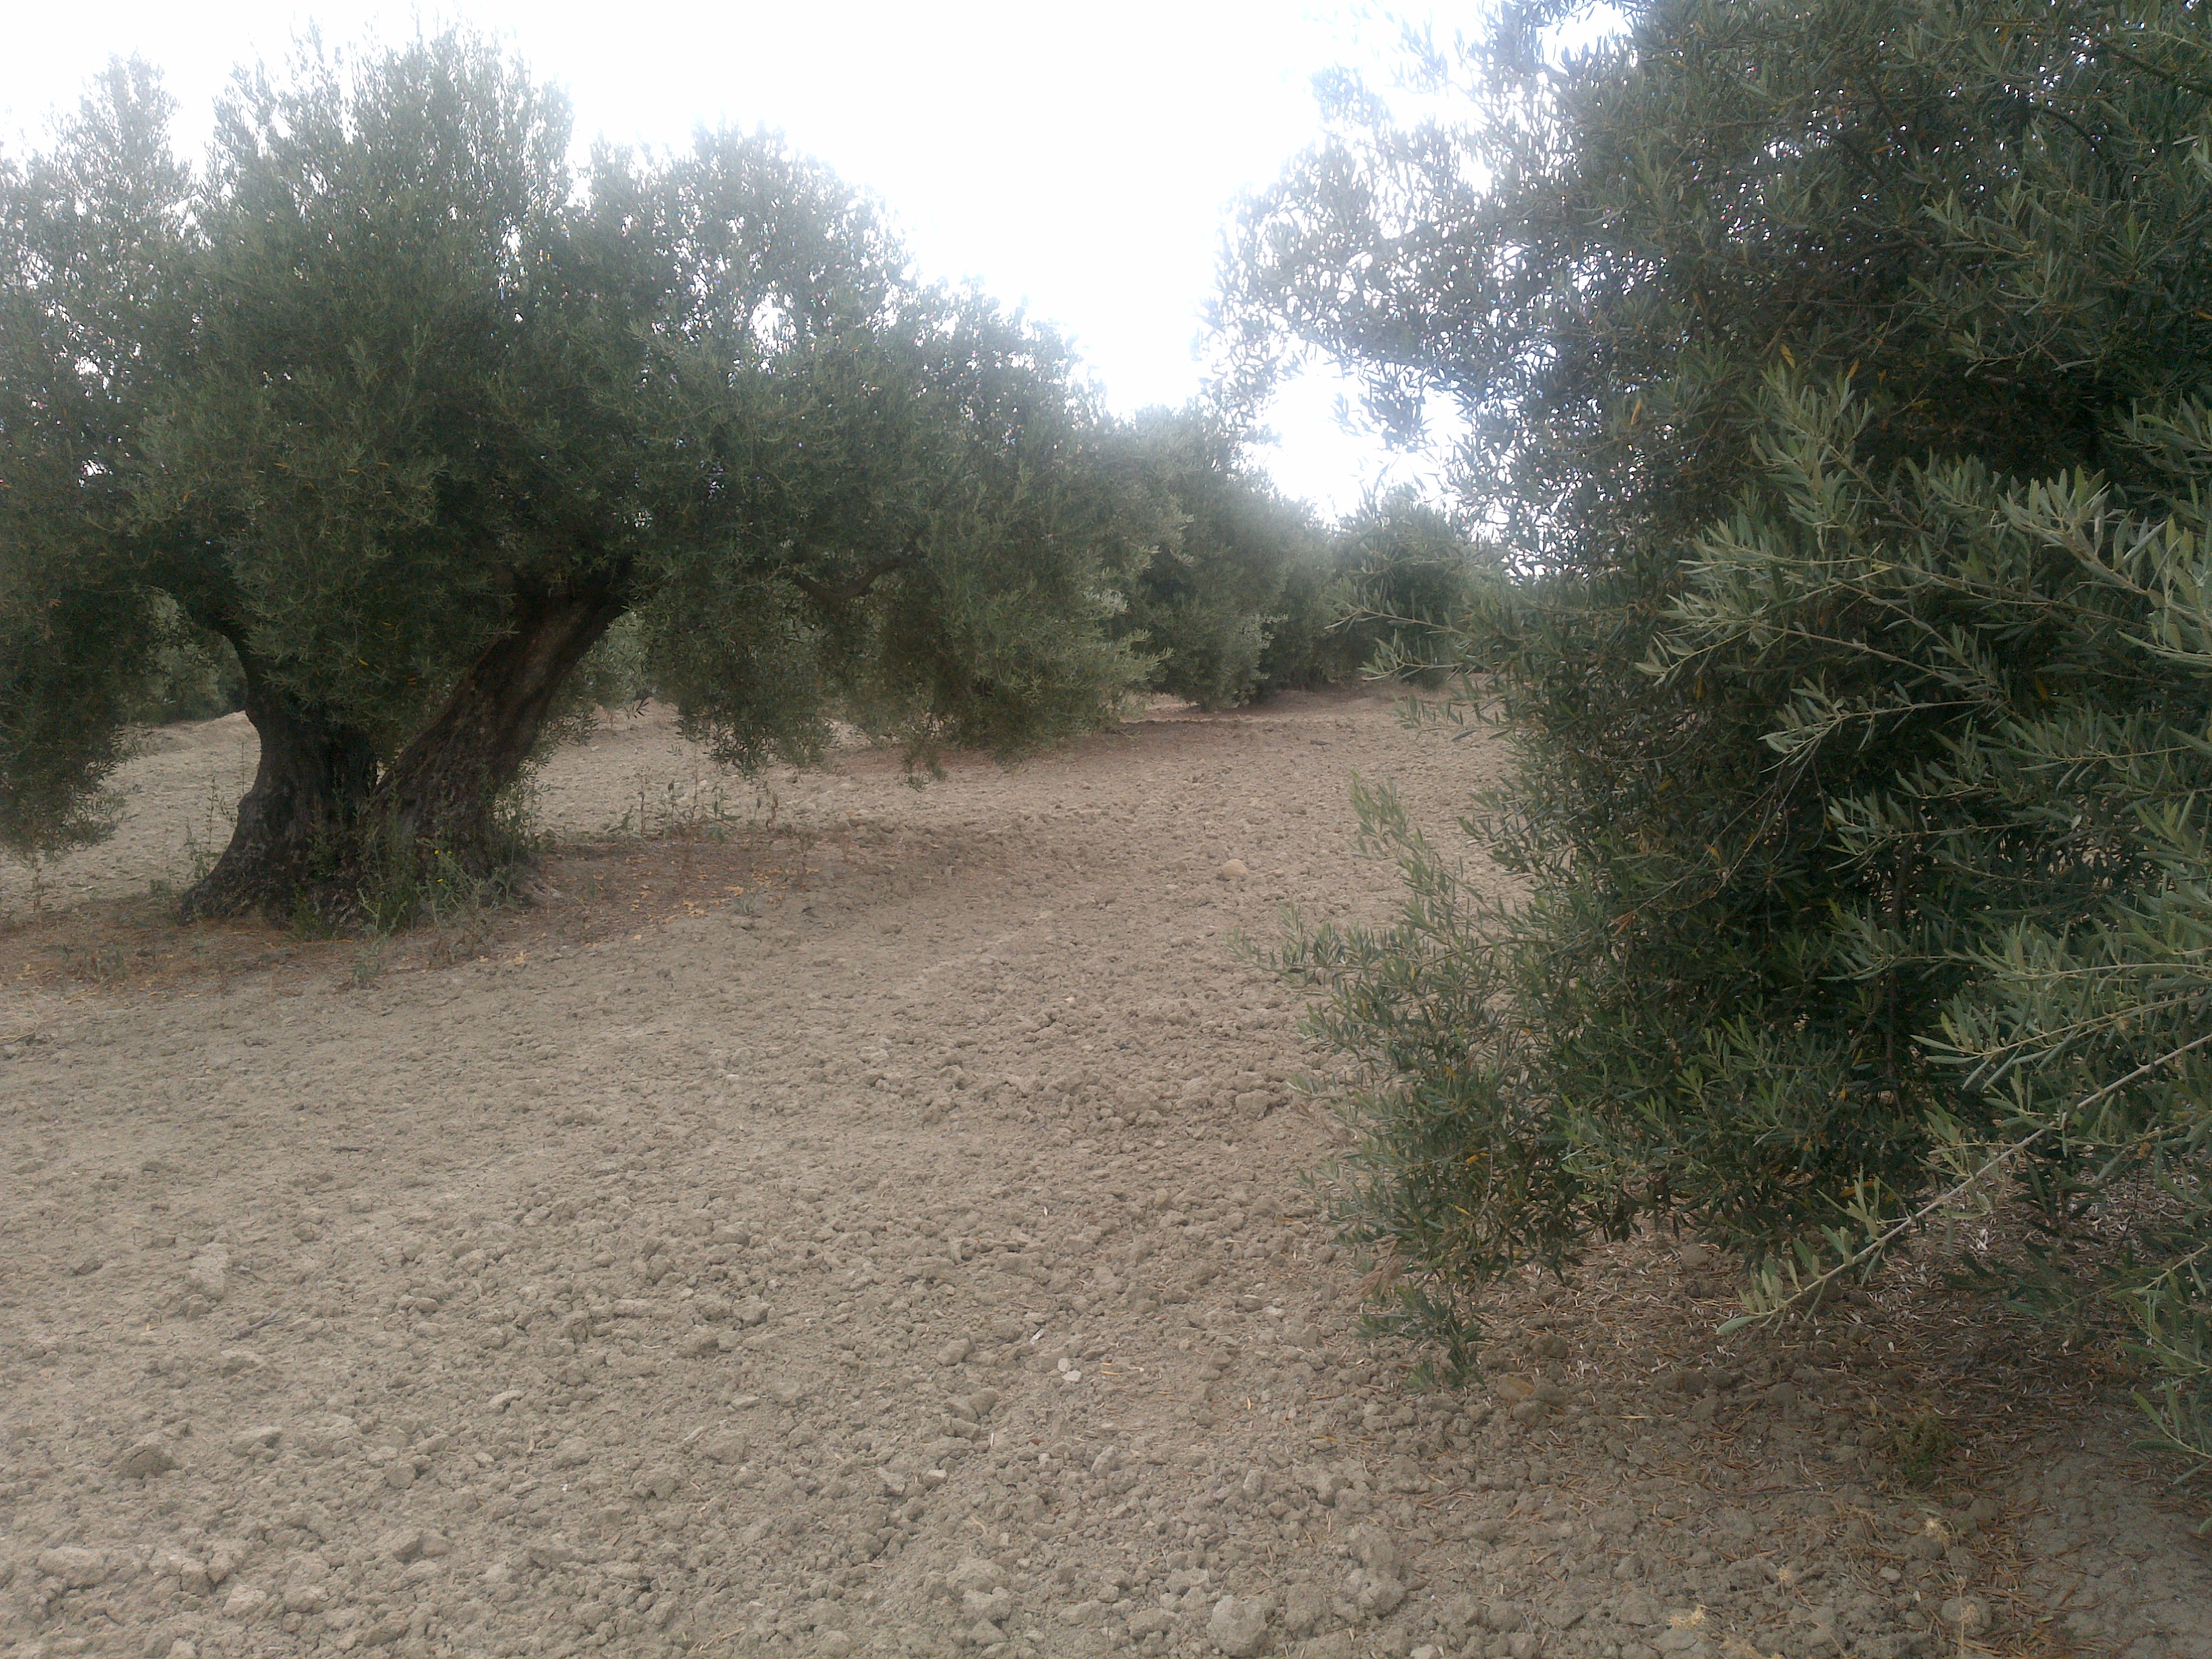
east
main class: Cropland
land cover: Olive groves
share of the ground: 50 - 75 %
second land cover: Other bare soil
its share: > 75 %
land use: Agriculture (excluding fallow land and kitchen gardens)
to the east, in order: Olive groves; Other bare soil
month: June
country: ES
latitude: 37.9163
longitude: -4.2612
